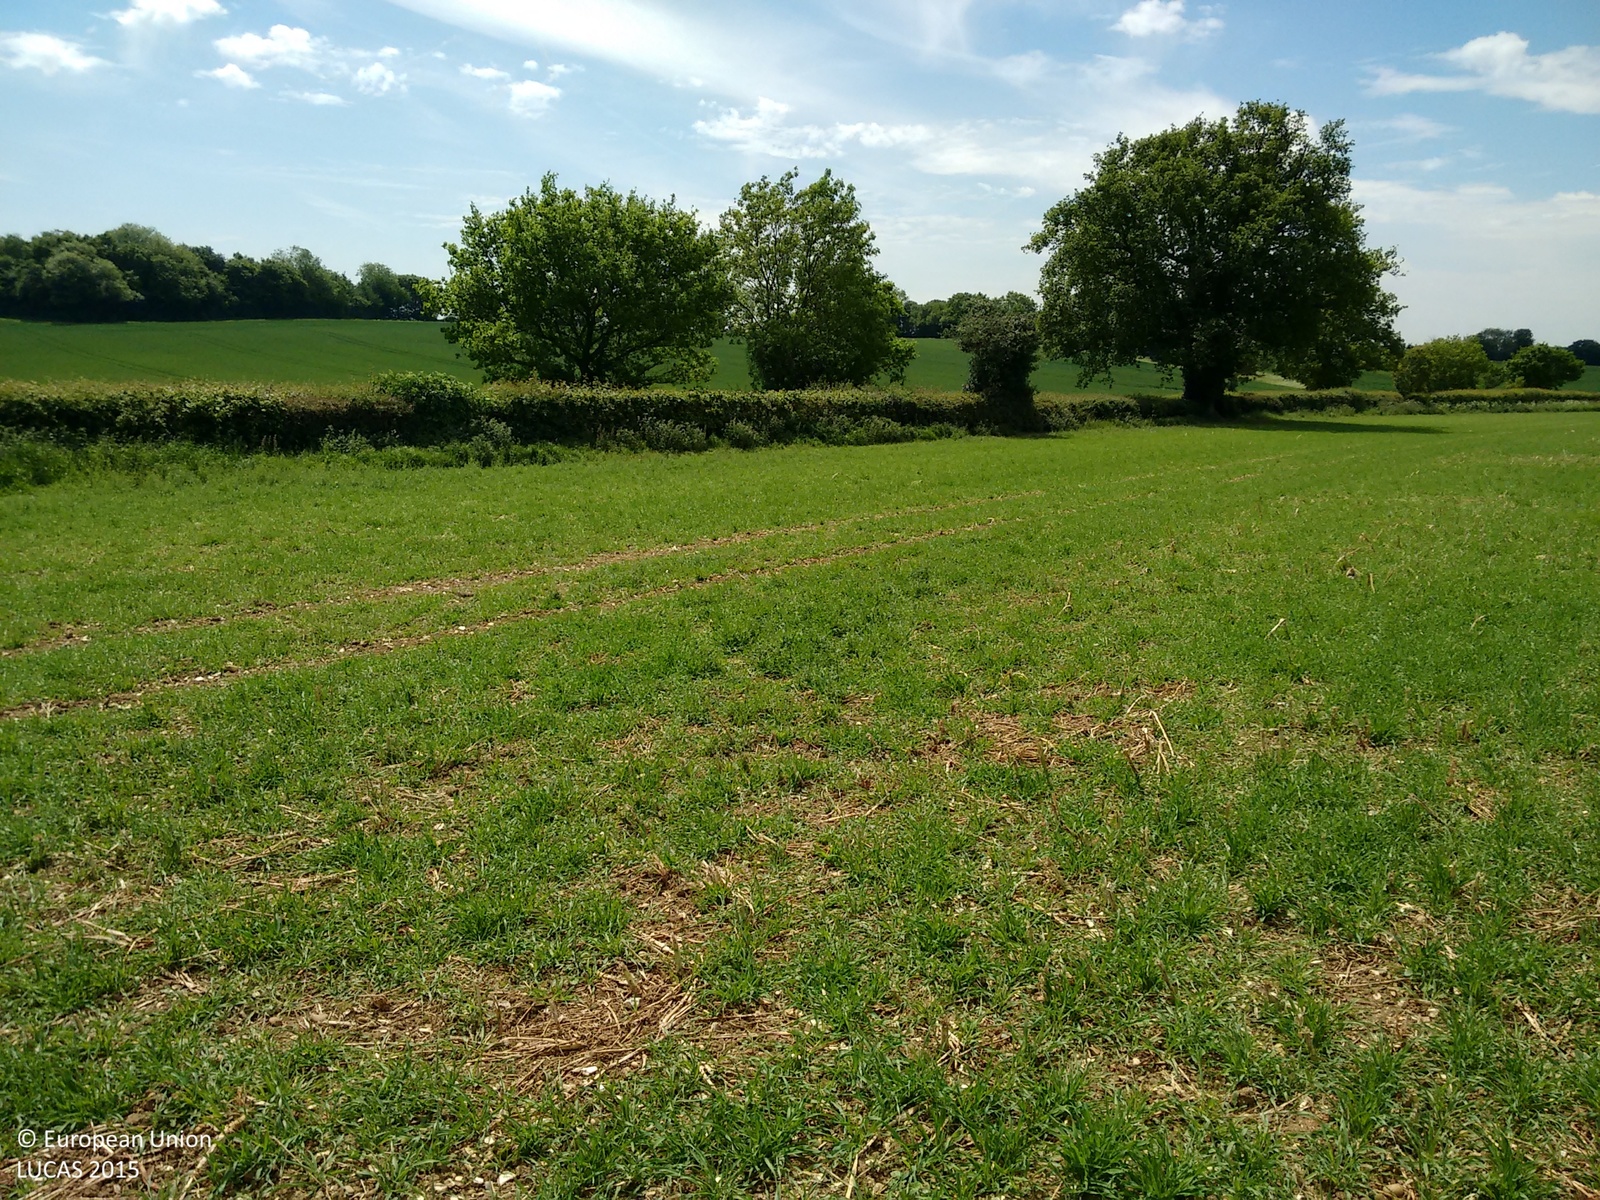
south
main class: Cropland
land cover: Barley
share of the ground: > 75 %
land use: Agriculture (excluding fallow land and kitchen gardens)
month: June
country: GB
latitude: 51.8023
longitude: -0.2888
